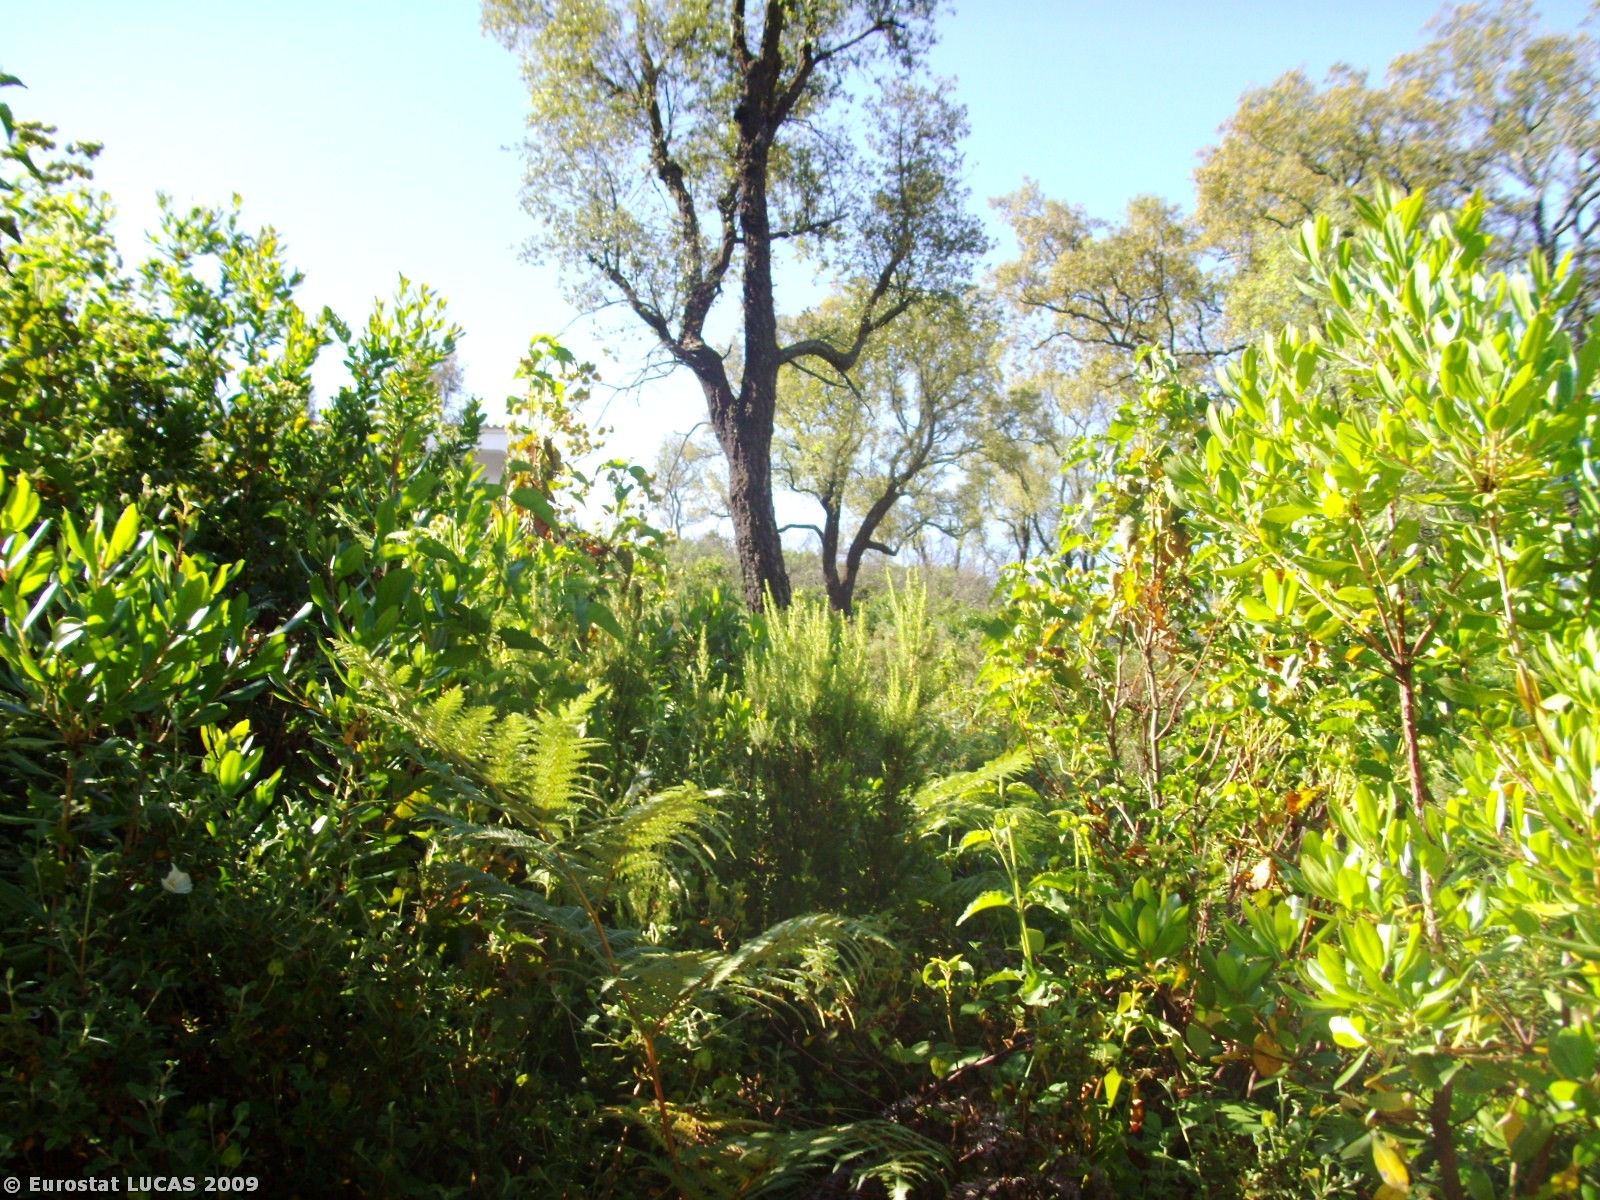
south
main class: Shrubland
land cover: Shrubland with sparse tree cover
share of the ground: > 75 %
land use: Nature reserves
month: June
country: PT
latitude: 37.3191
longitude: -8.5242
